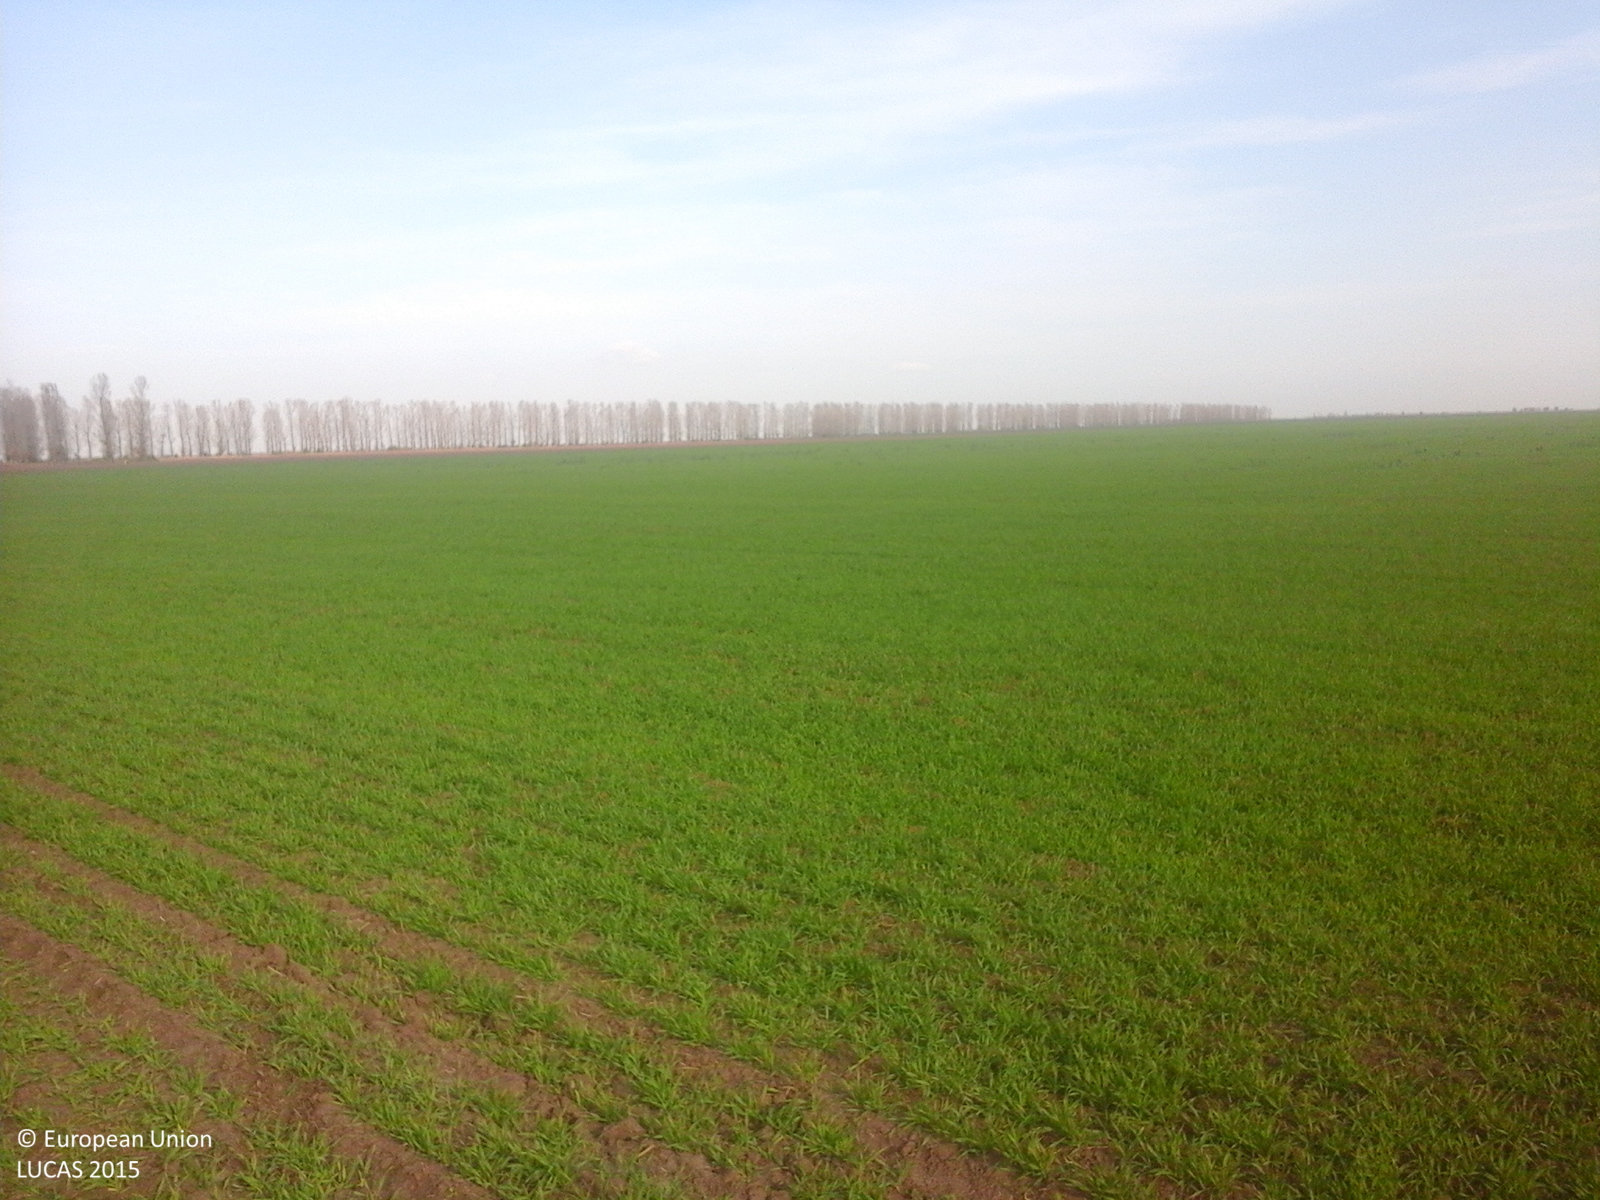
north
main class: Cropland
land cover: Common wheat
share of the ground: > 75 %
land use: Agriculture (excluding fallow land and kitchen gardens)
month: October
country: RO
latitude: 45.2913
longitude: 27.2163
